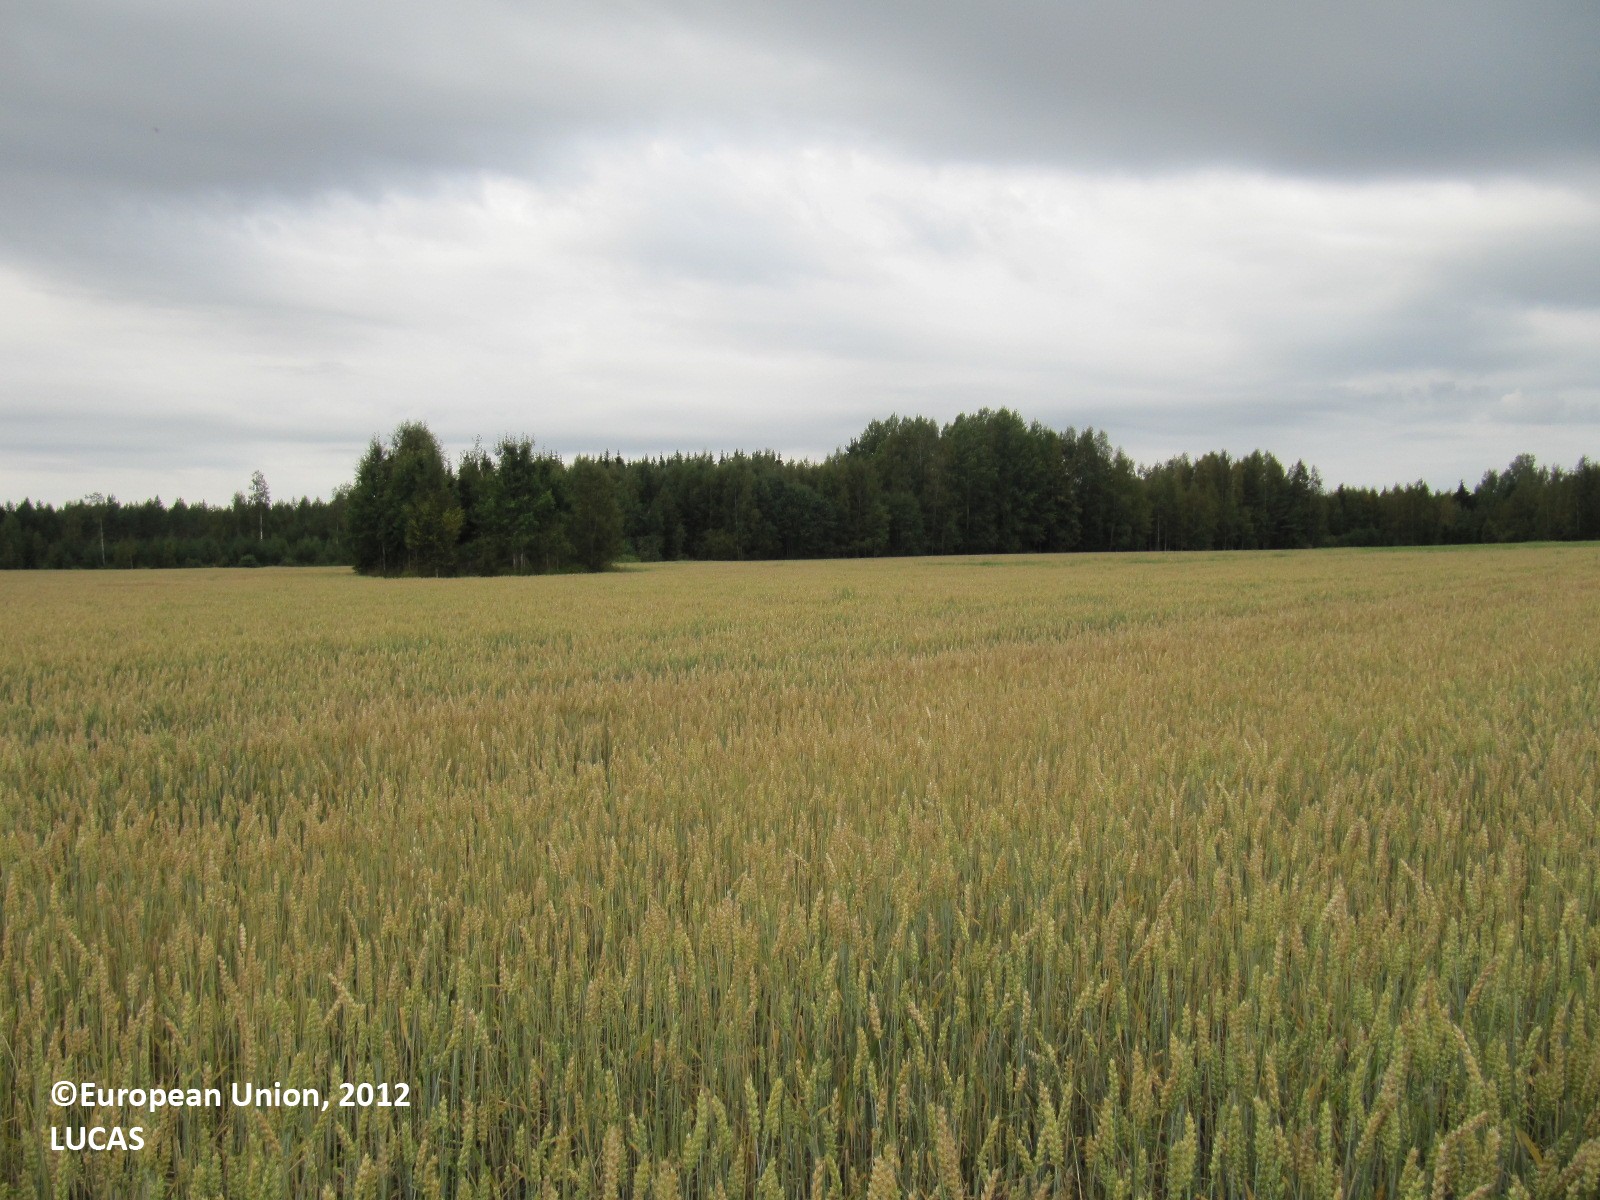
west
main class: Cropland
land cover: Common wheat
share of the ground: > 75 %
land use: Agriculture (excluding fallow land and kitchen gardens)
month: August
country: FI
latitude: 61.0970
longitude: 22.9638
